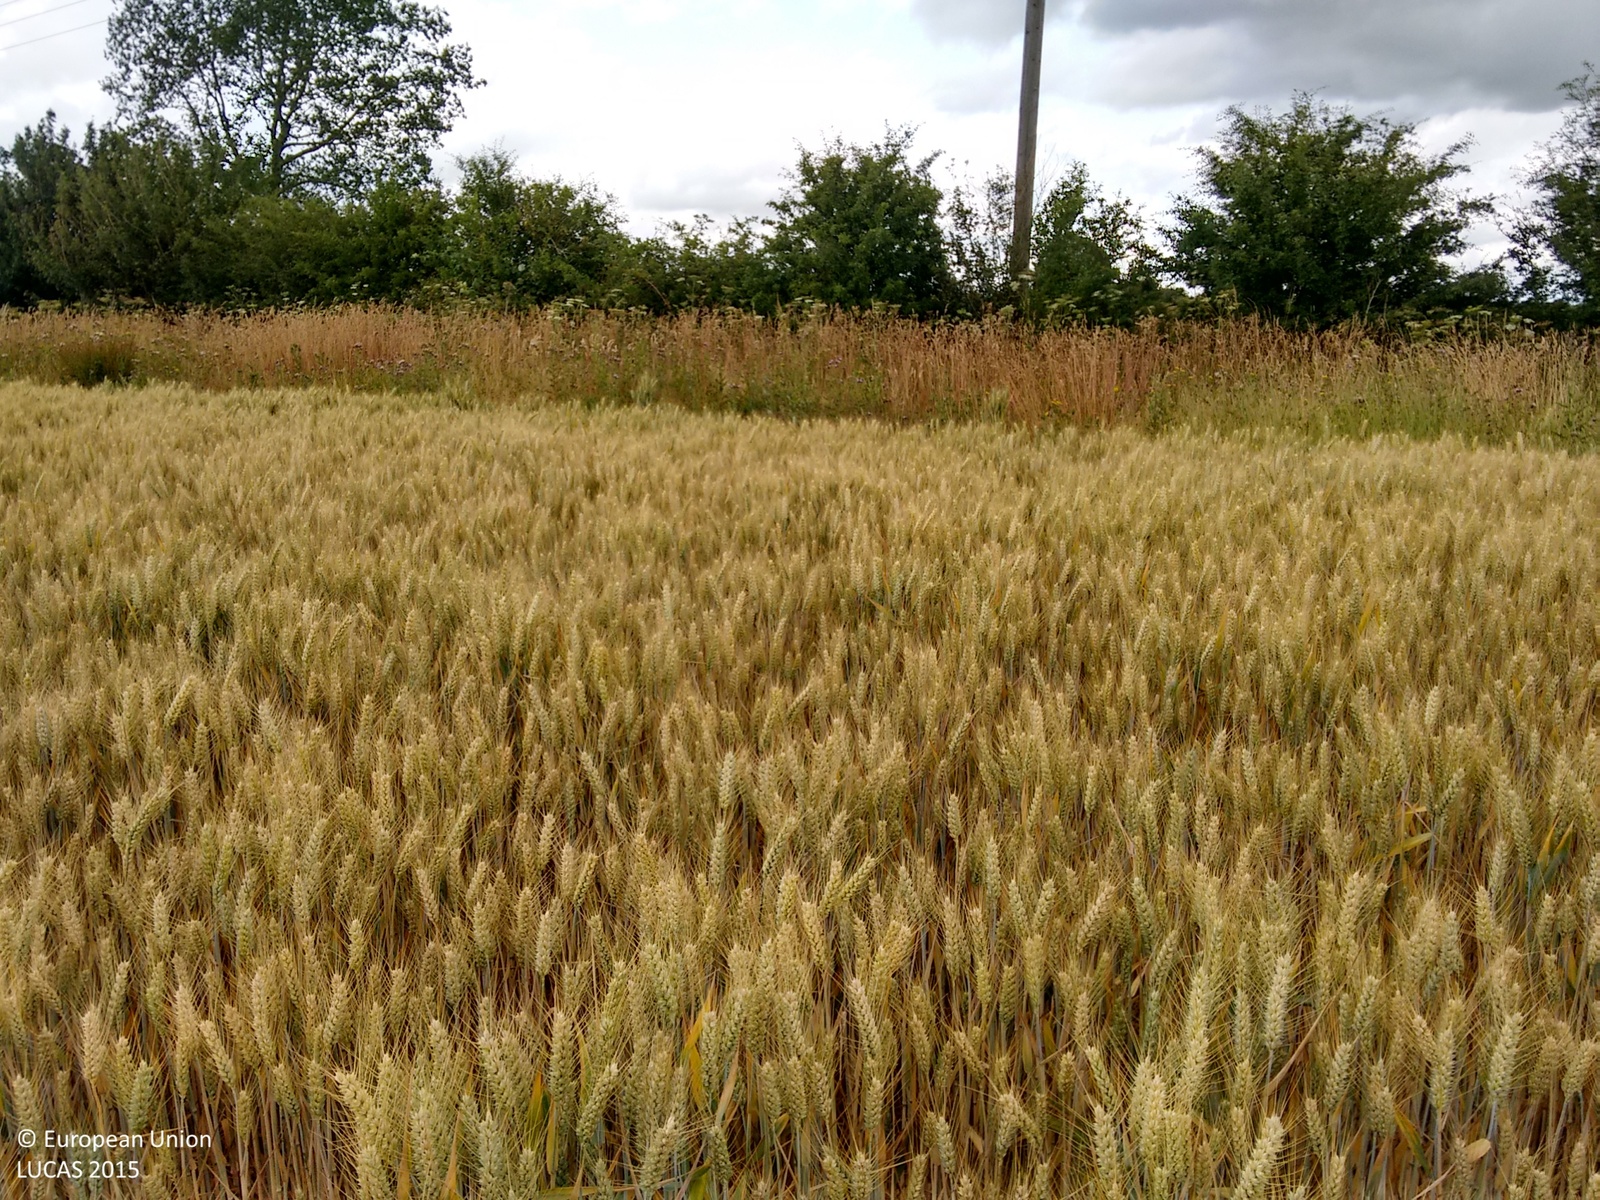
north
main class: Cropland
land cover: Common wheat
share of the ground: > 75 %
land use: Agriculture (excluding fallow land and kitchen gardens)
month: July
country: GB
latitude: 52.4312
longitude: 0.0698
